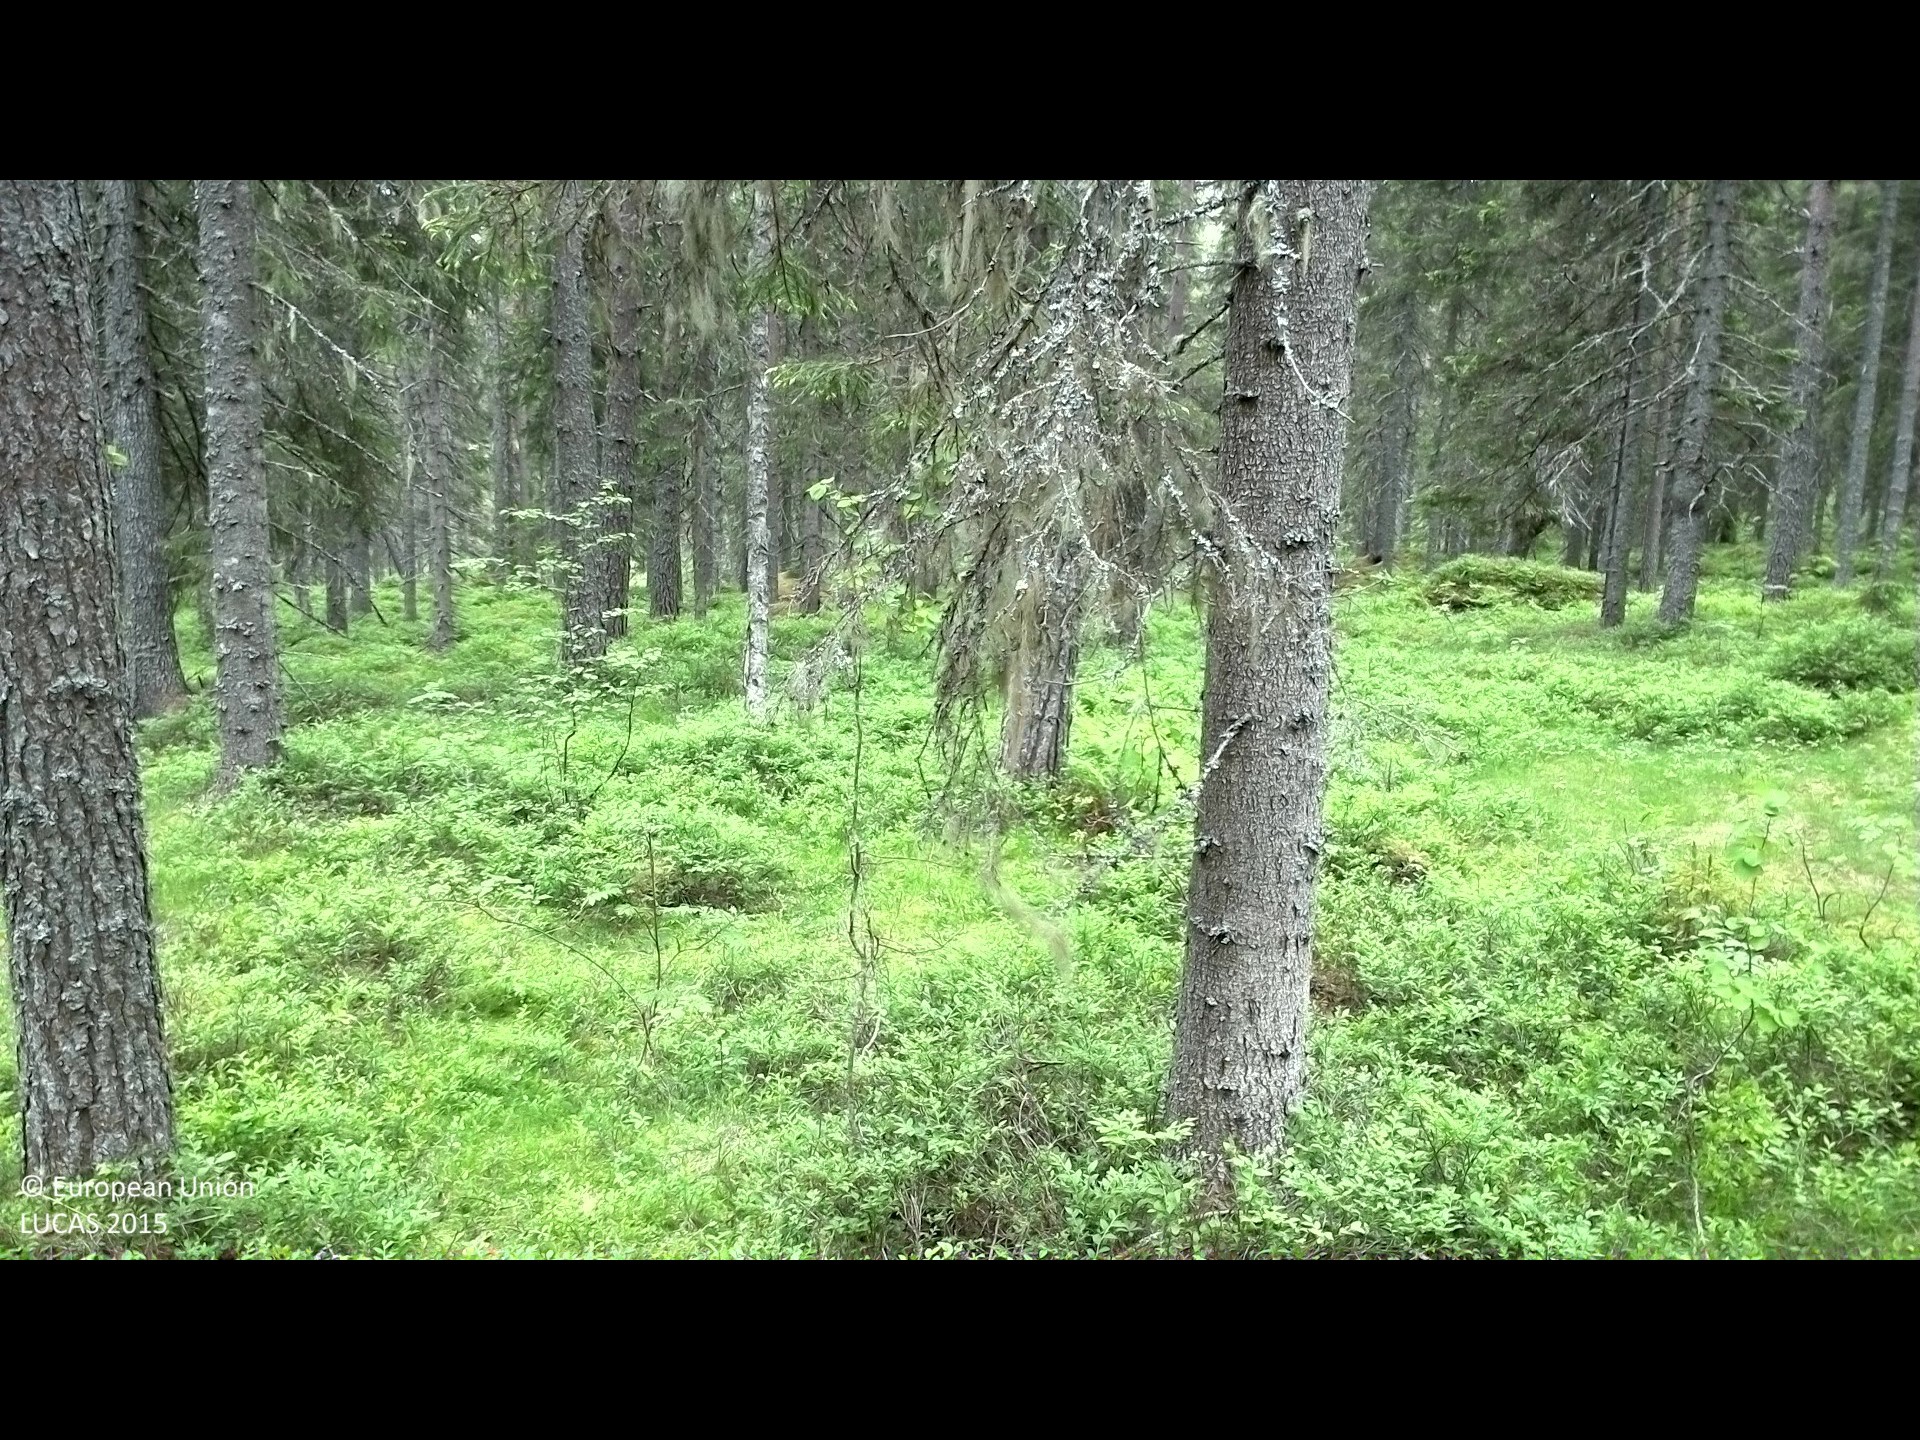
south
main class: Woodland
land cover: Spruce dominated coniferous woodland
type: boreal forest
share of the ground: 25 - 50 %
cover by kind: shrubs 40 %, coniferous forest trees 35 %, herbaceous plants 15 %, broadleaved forest trees 5 %, lichens and mosses 5 %
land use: Forestry
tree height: > 5 m
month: June
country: SE
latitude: 61.9472
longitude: 16.9014
